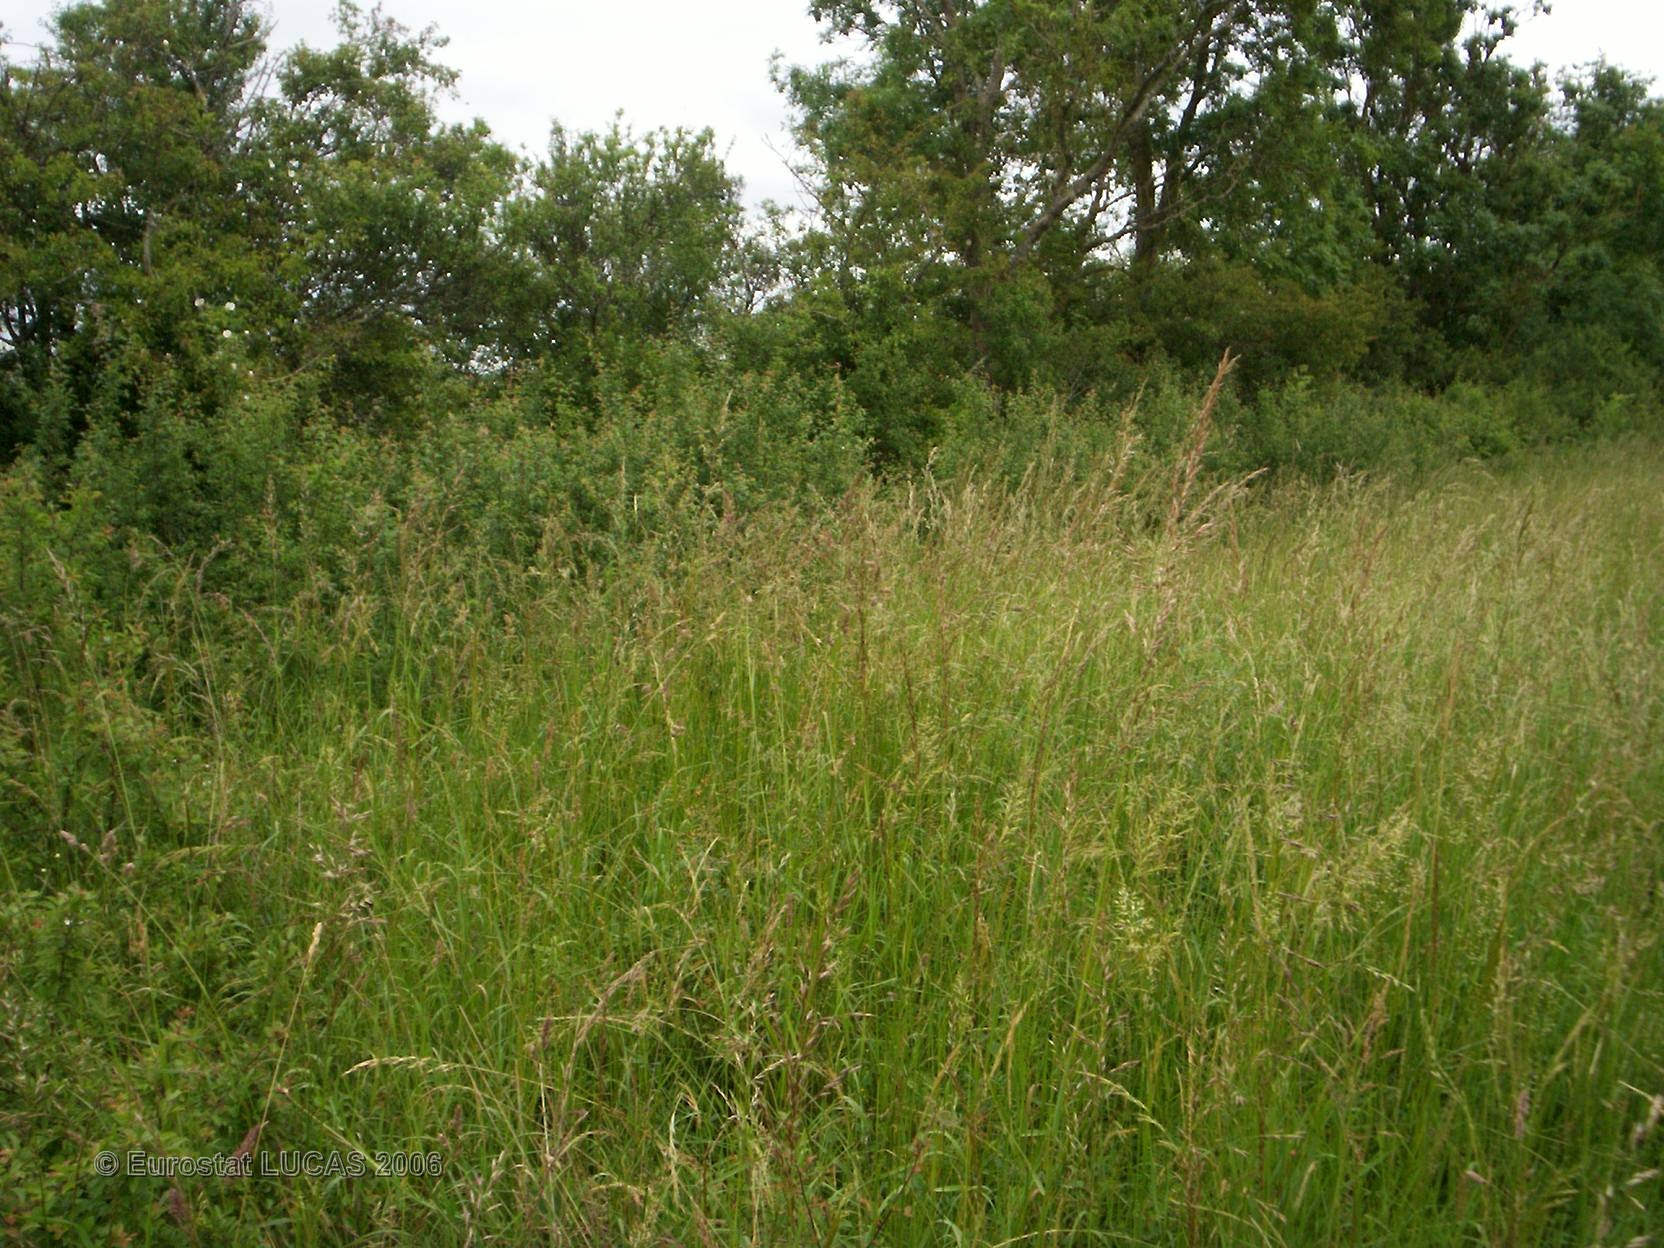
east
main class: Grassland
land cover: Grassland without tree/shrub cover
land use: Agriculture (excluding fallow land and kitchen gardens)
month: May
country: FR
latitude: 46.0293
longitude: -0.8934
